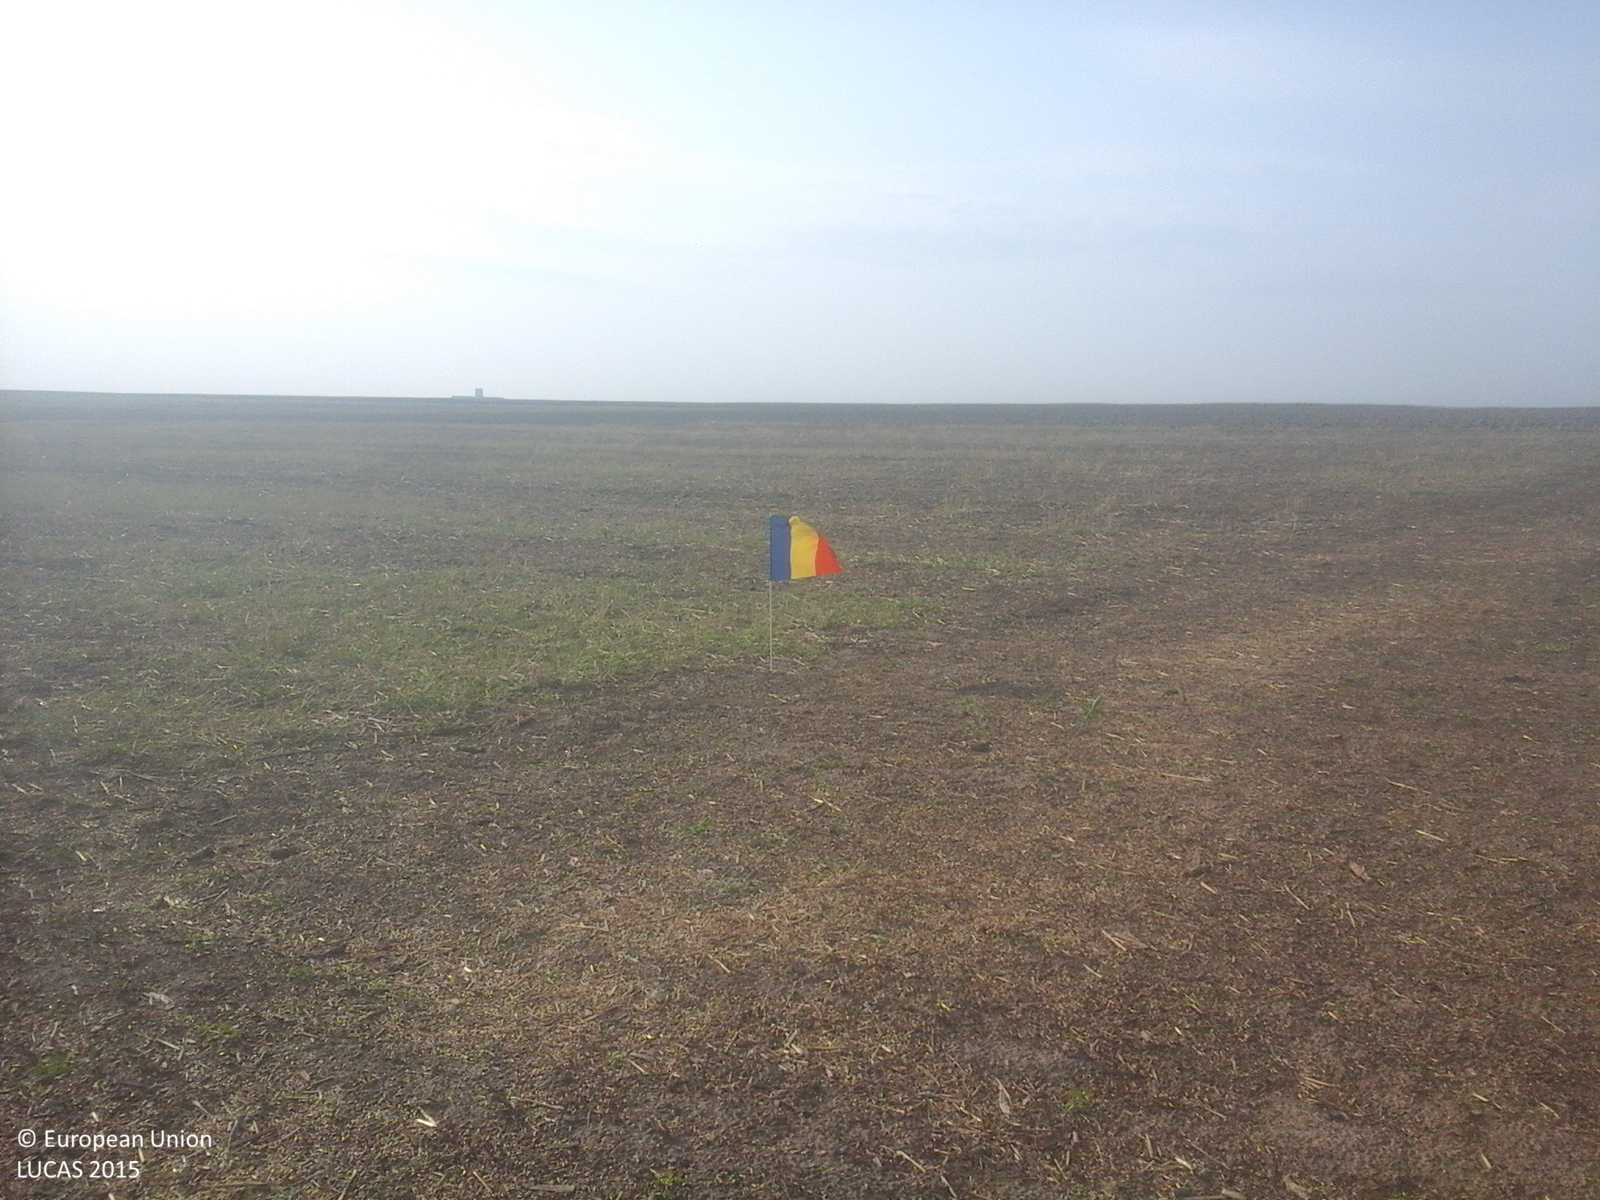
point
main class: Cropland
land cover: Common wheat
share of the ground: < 10 %
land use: Agriculture (excluding fallow land and kitchen gardens)
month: August
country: RO
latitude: 43.9928
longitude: 28.2269
